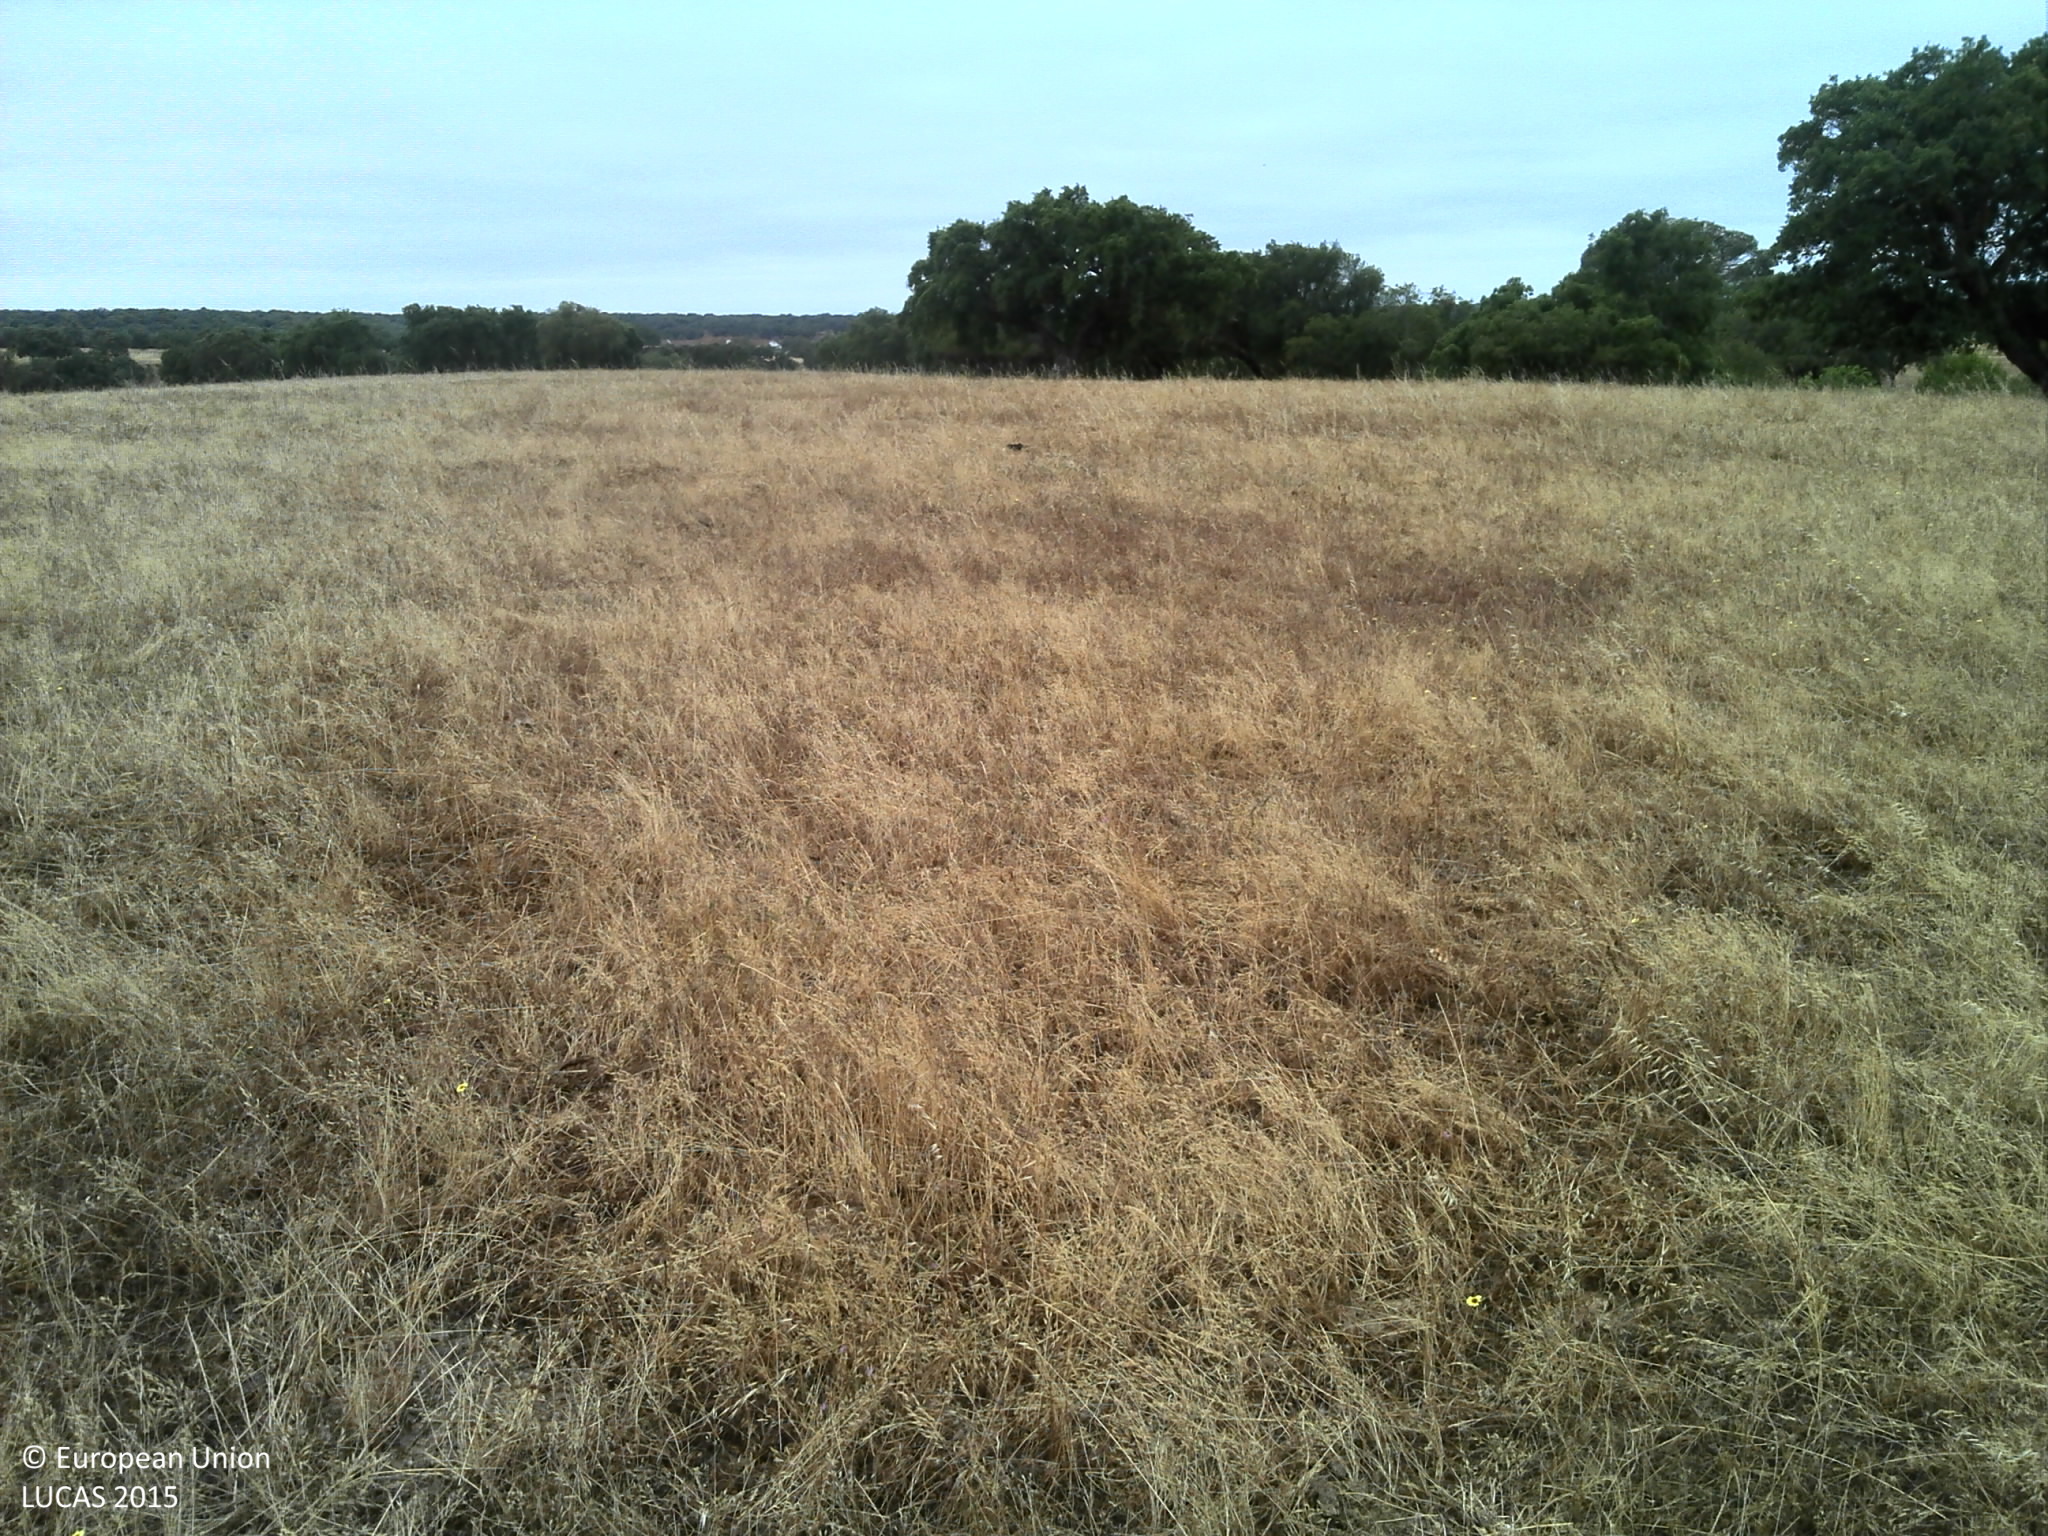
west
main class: Grassland
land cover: Grassland without tree/shrub cover
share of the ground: 50 - 75 %
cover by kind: herbaceous plants 70 %, unconsolidated bare surface 30 %
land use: Agriculture (excluding fallow land and kitchen gardens)
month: June
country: PT
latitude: 37.9991
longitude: -8.3625
